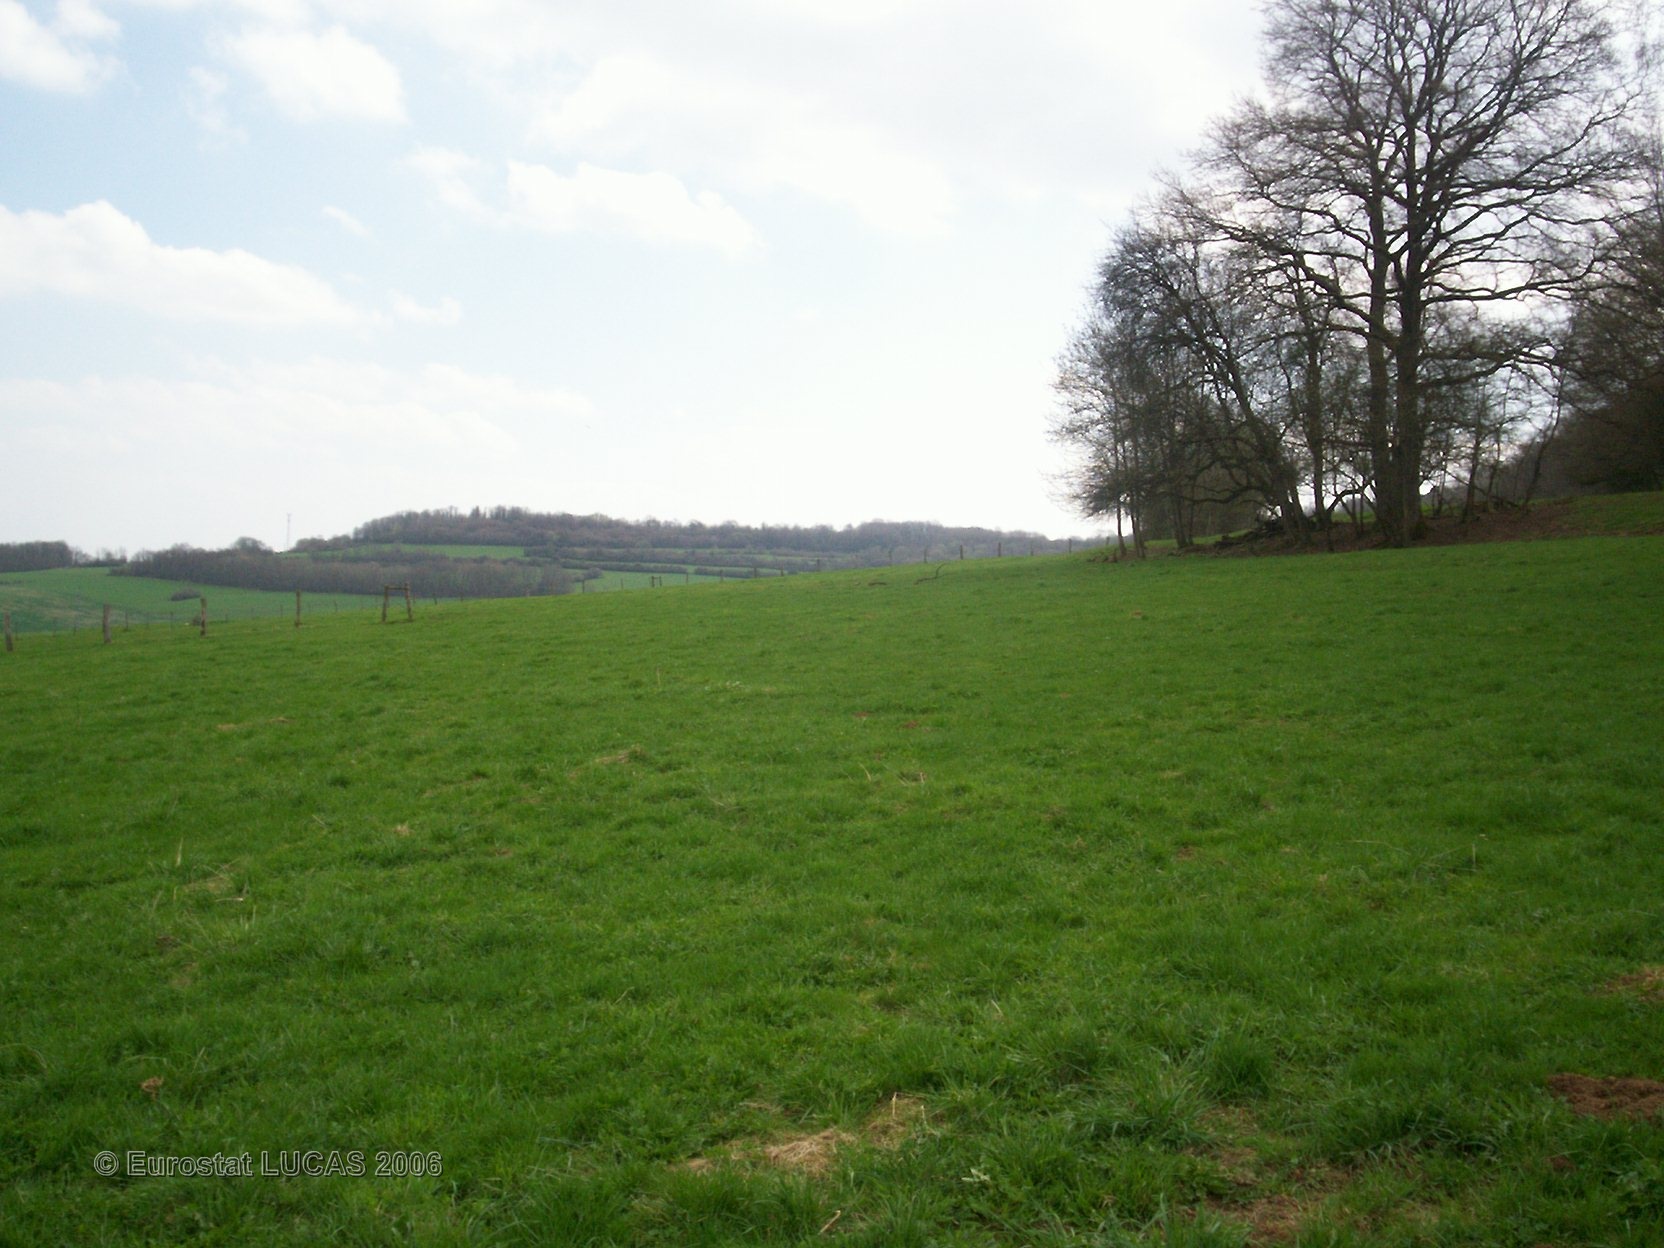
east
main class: Grassland
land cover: Grassland without tree/shrub cover
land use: Agriculture (excluding fallow land and kitchen gardens)
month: April
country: FR
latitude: 47.8881
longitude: 5.2789
